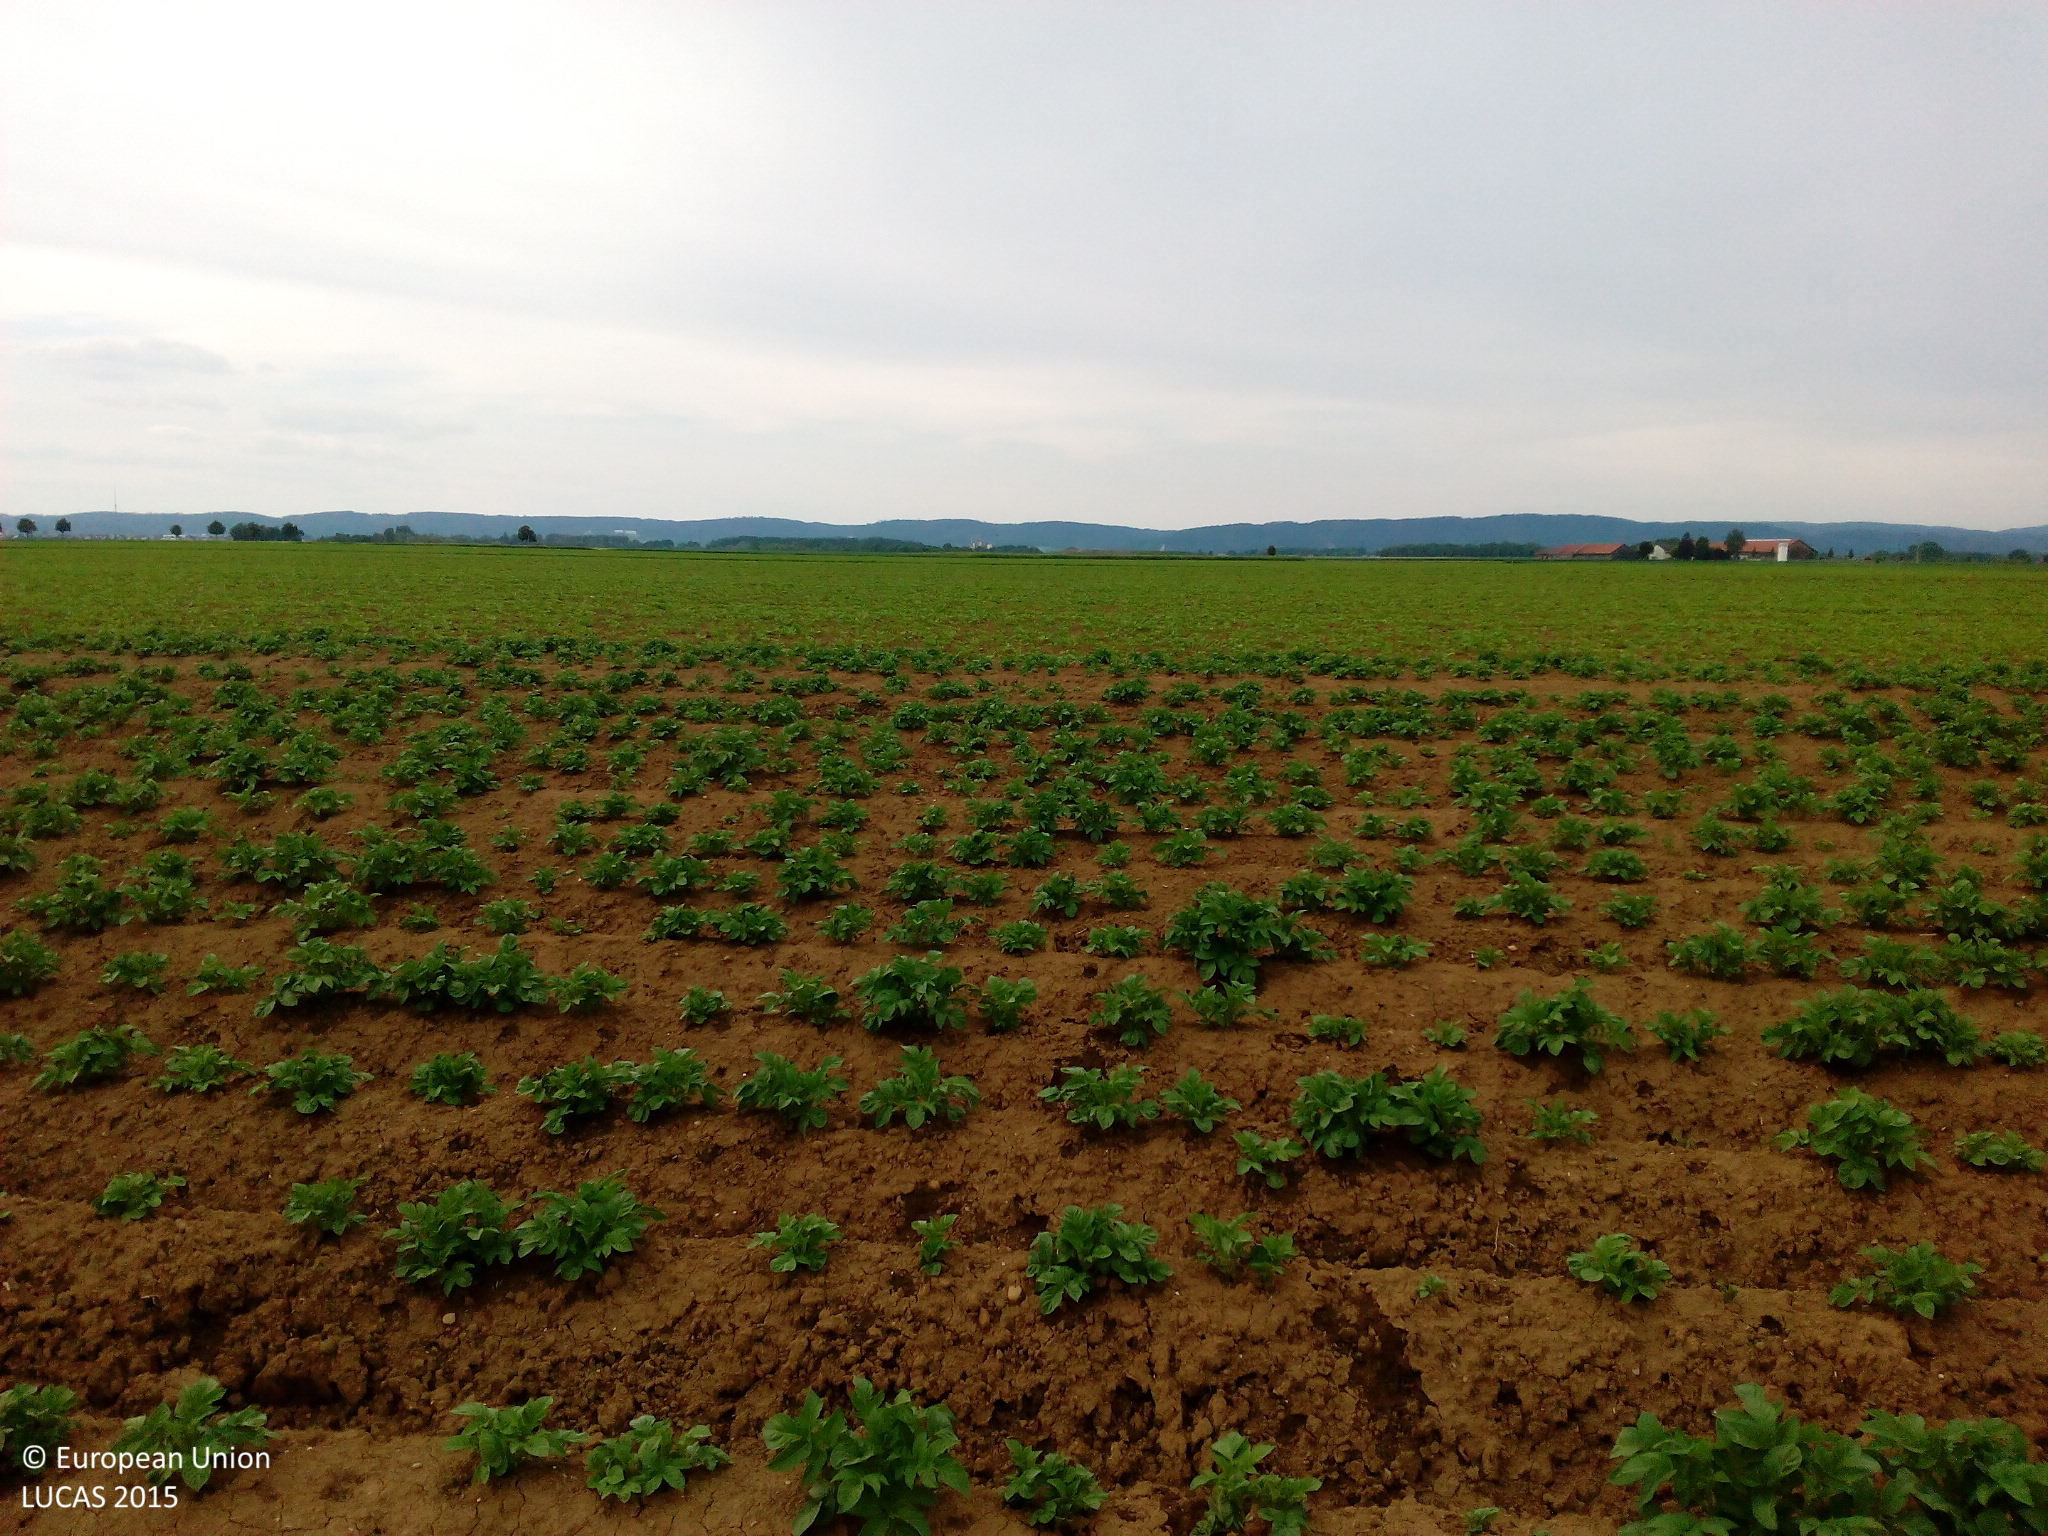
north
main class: Cropland
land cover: Potatoes
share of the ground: 10 - 25 %
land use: Agriculture (excluding fallow land and kitchen gardens)
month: May
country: DE
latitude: 48.9571
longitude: 12.2255
